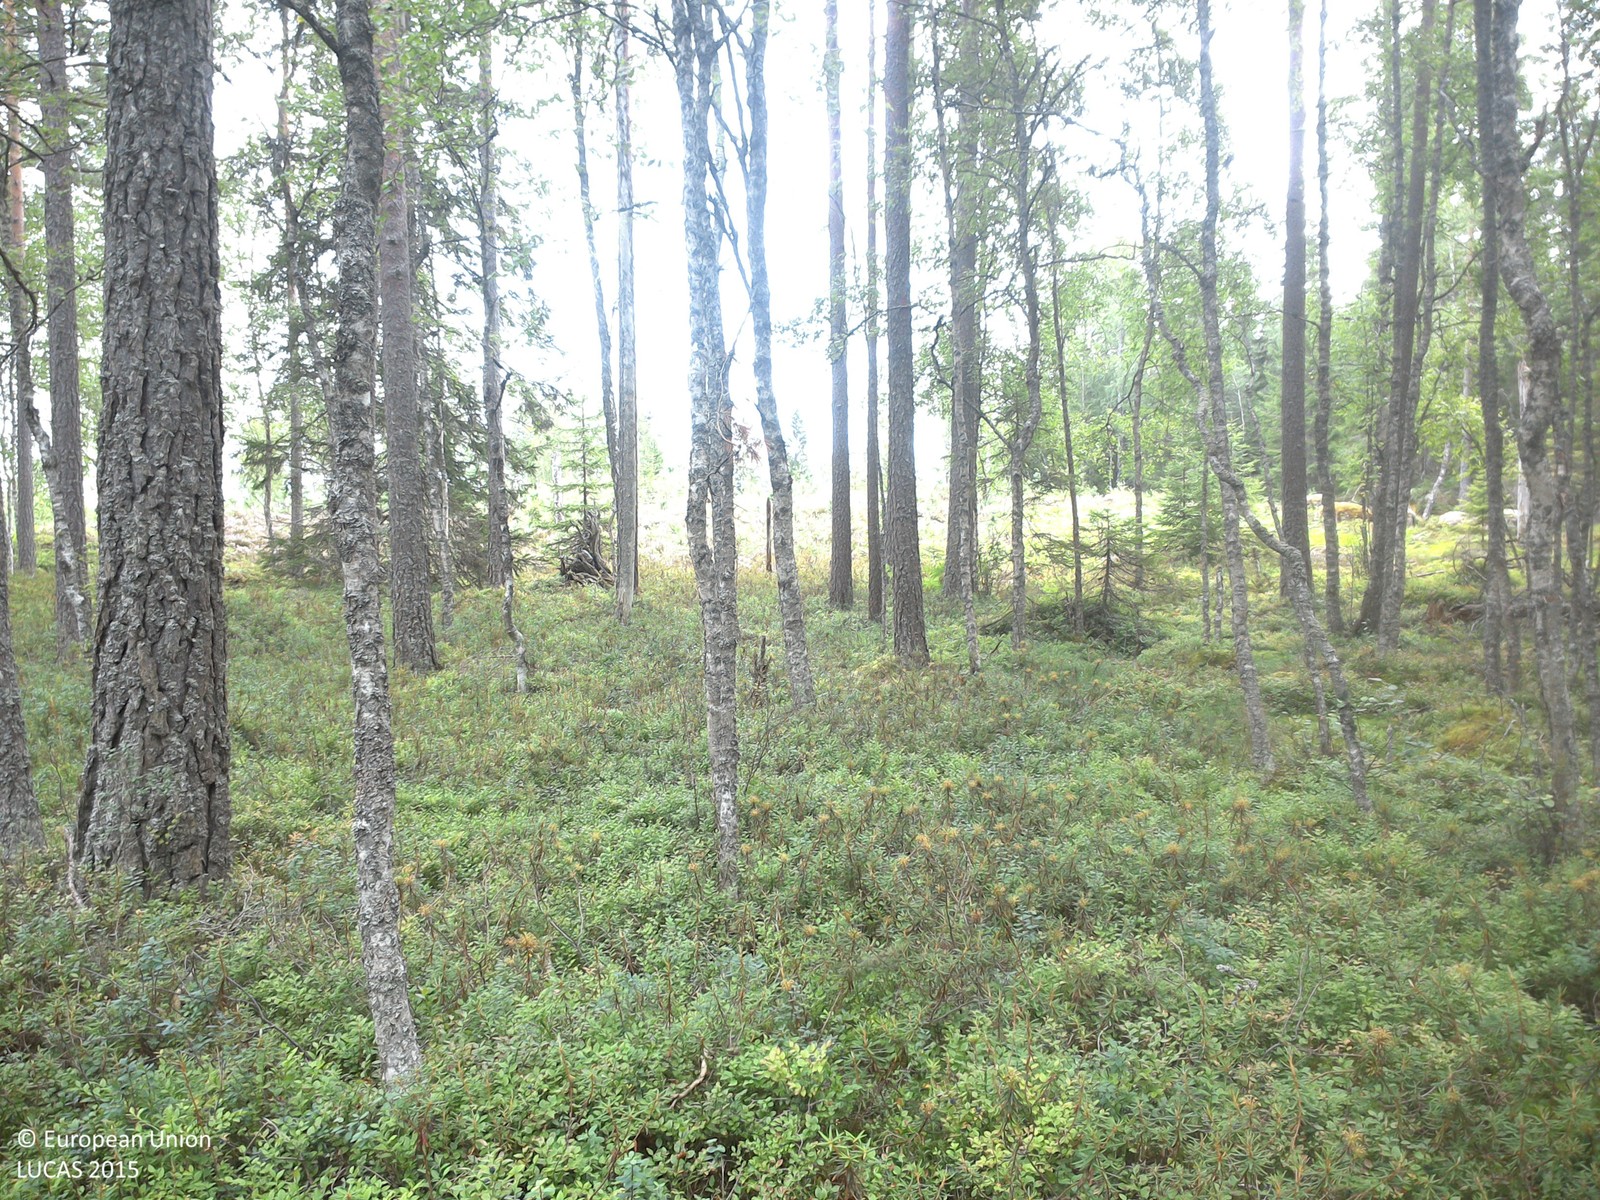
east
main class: Woodland
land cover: Pine dominated mixed woodland
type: boreal forest
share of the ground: 25 - 50 %
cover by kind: herbaceous plants 45 %, coniferous forest trees 30 %, lichens and mosses 15 %, broadleaved forest trees 10 %
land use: Forestry
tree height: > 5 m
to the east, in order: Pine dominated mixed woodland; Shrubland with sparse tree cover; Spruce dominated mixed woodland; Spruce dominated coniferous woodland; Pine dominated mixed woodland; Spruce dominated mixed woodland; Rivers and streams
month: August
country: SE
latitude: 57.8198
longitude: 15.4672
